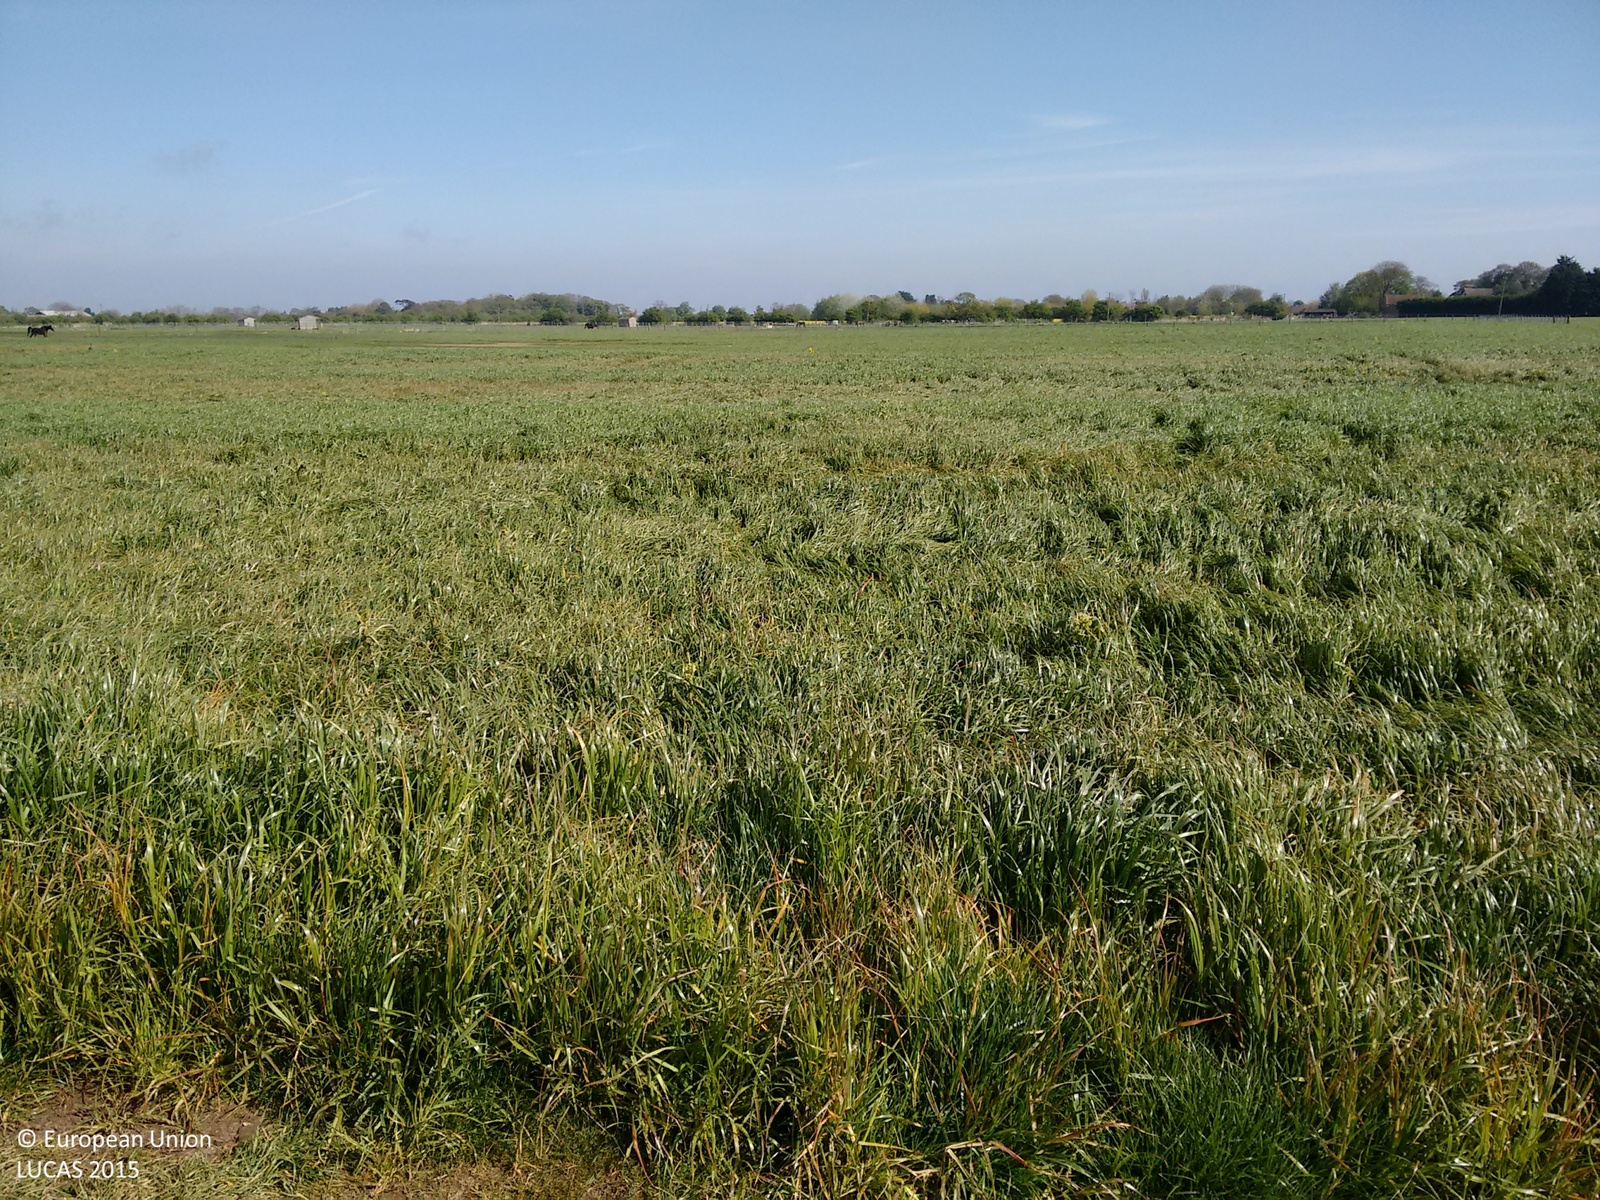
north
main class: Cropland
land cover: Rape and turnip rape
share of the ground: > 75 %
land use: Agriculture (excluding fallow land and kitchen gardens)
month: May
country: GB
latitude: 53.3672
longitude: 0.2169
